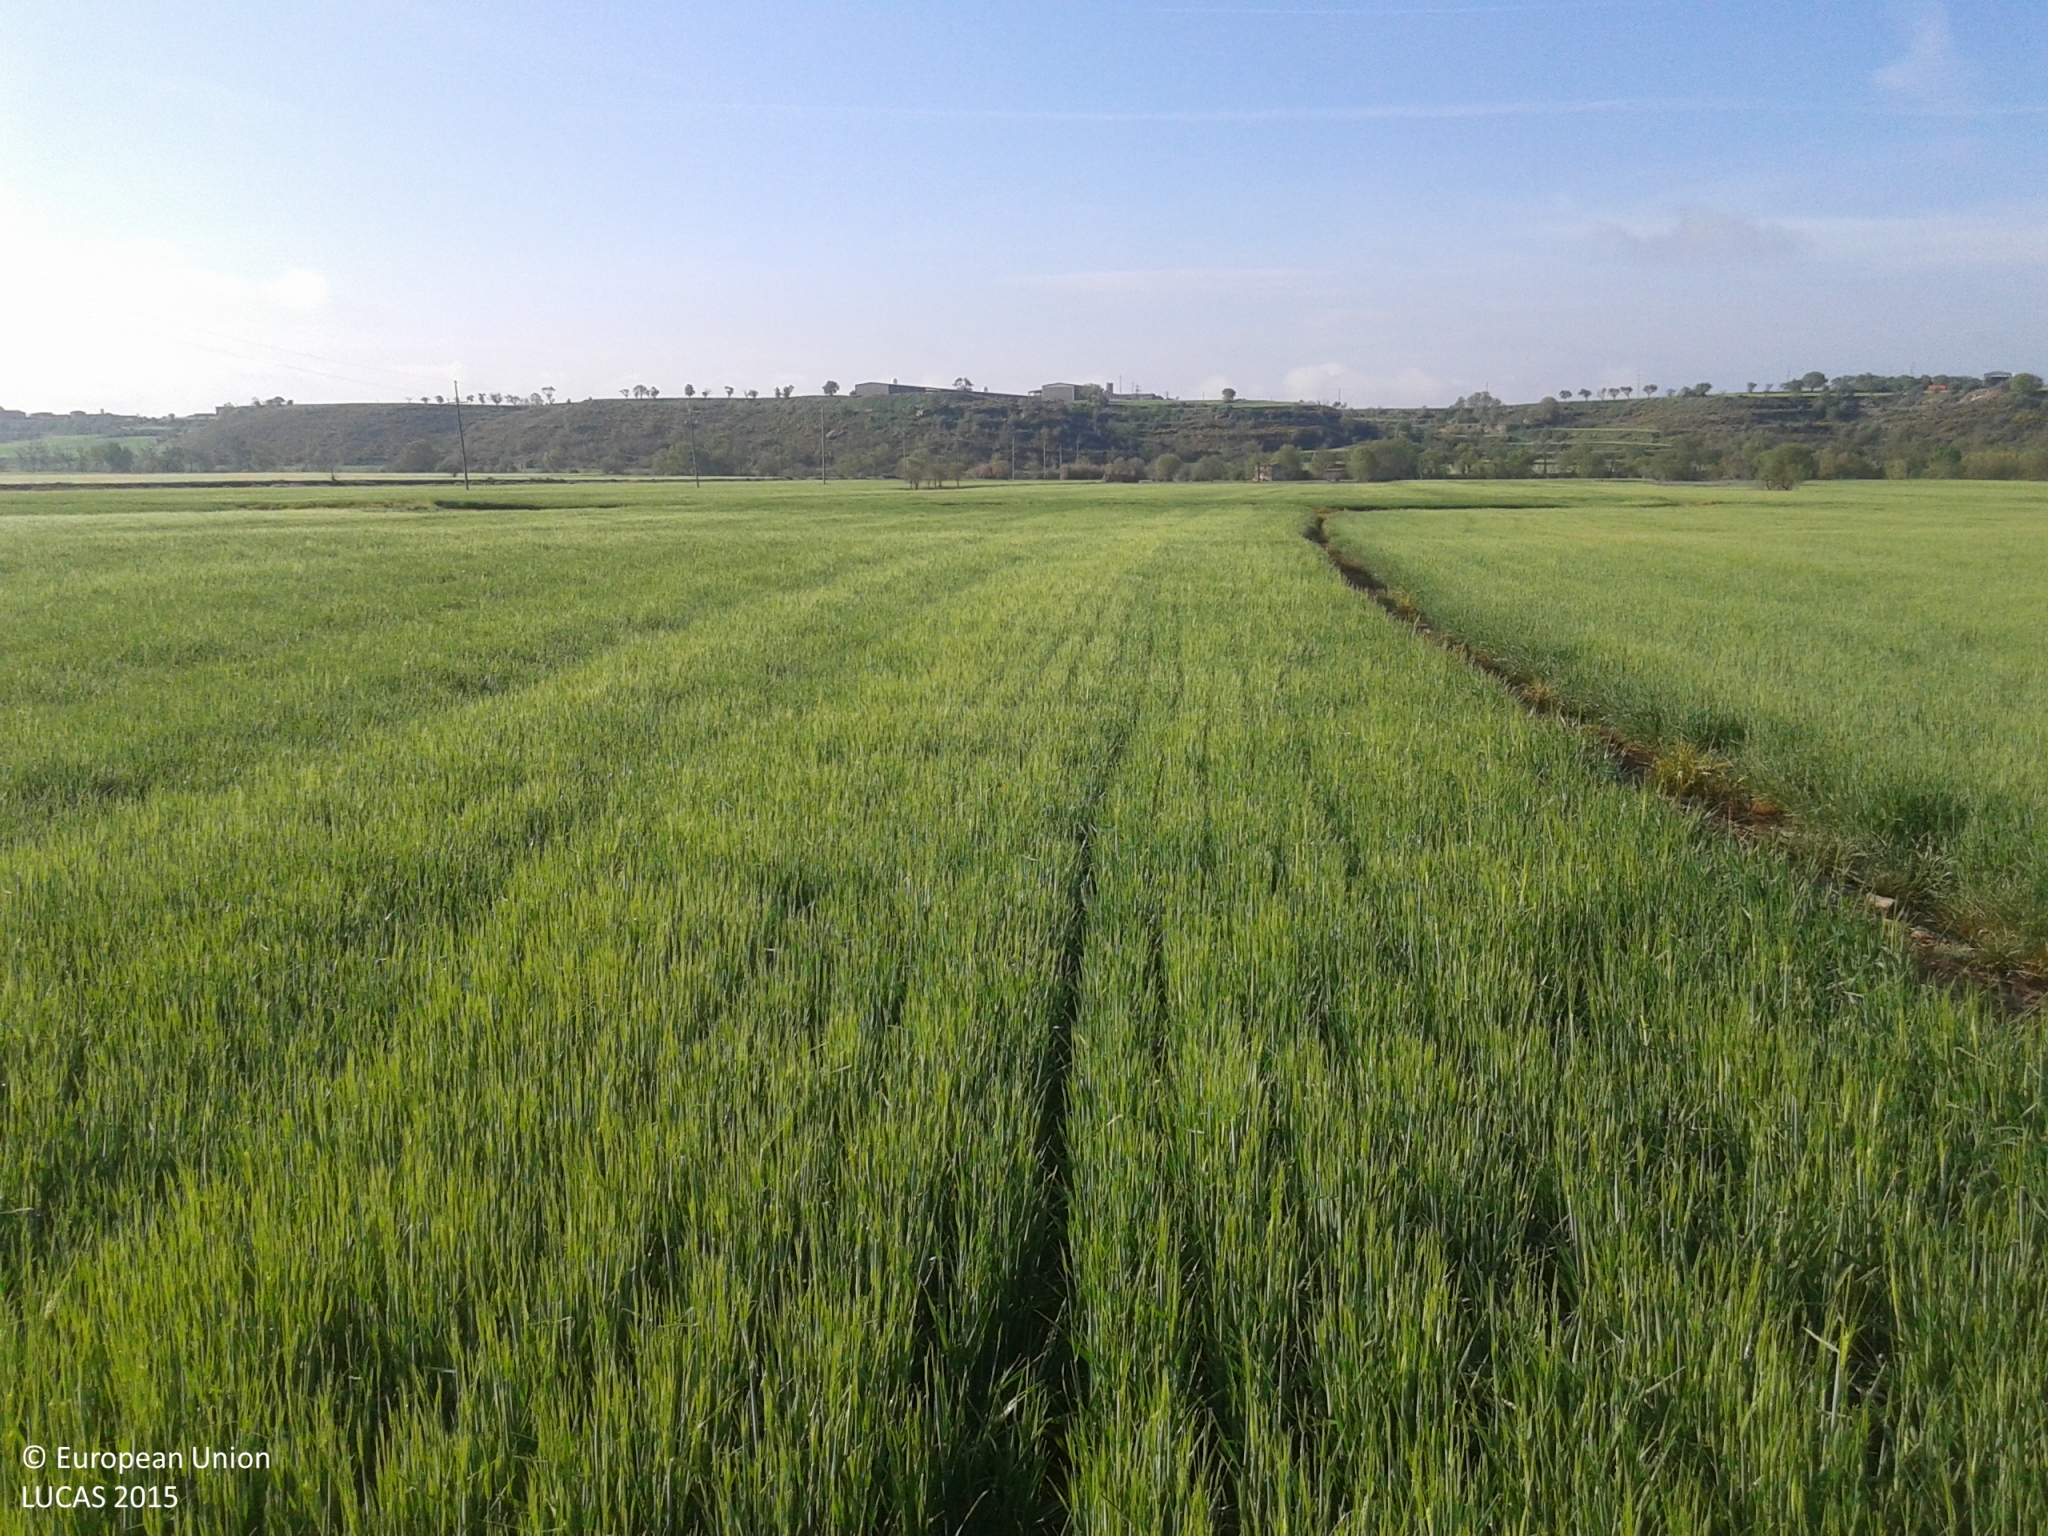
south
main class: Cropland
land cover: Barley
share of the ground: > 75 %
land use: Agriculture (excluding fallow land and kitchen gardens)
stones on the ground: 10 - 25 %
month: April
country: ES
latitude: 41.7595
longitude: 1.1726
